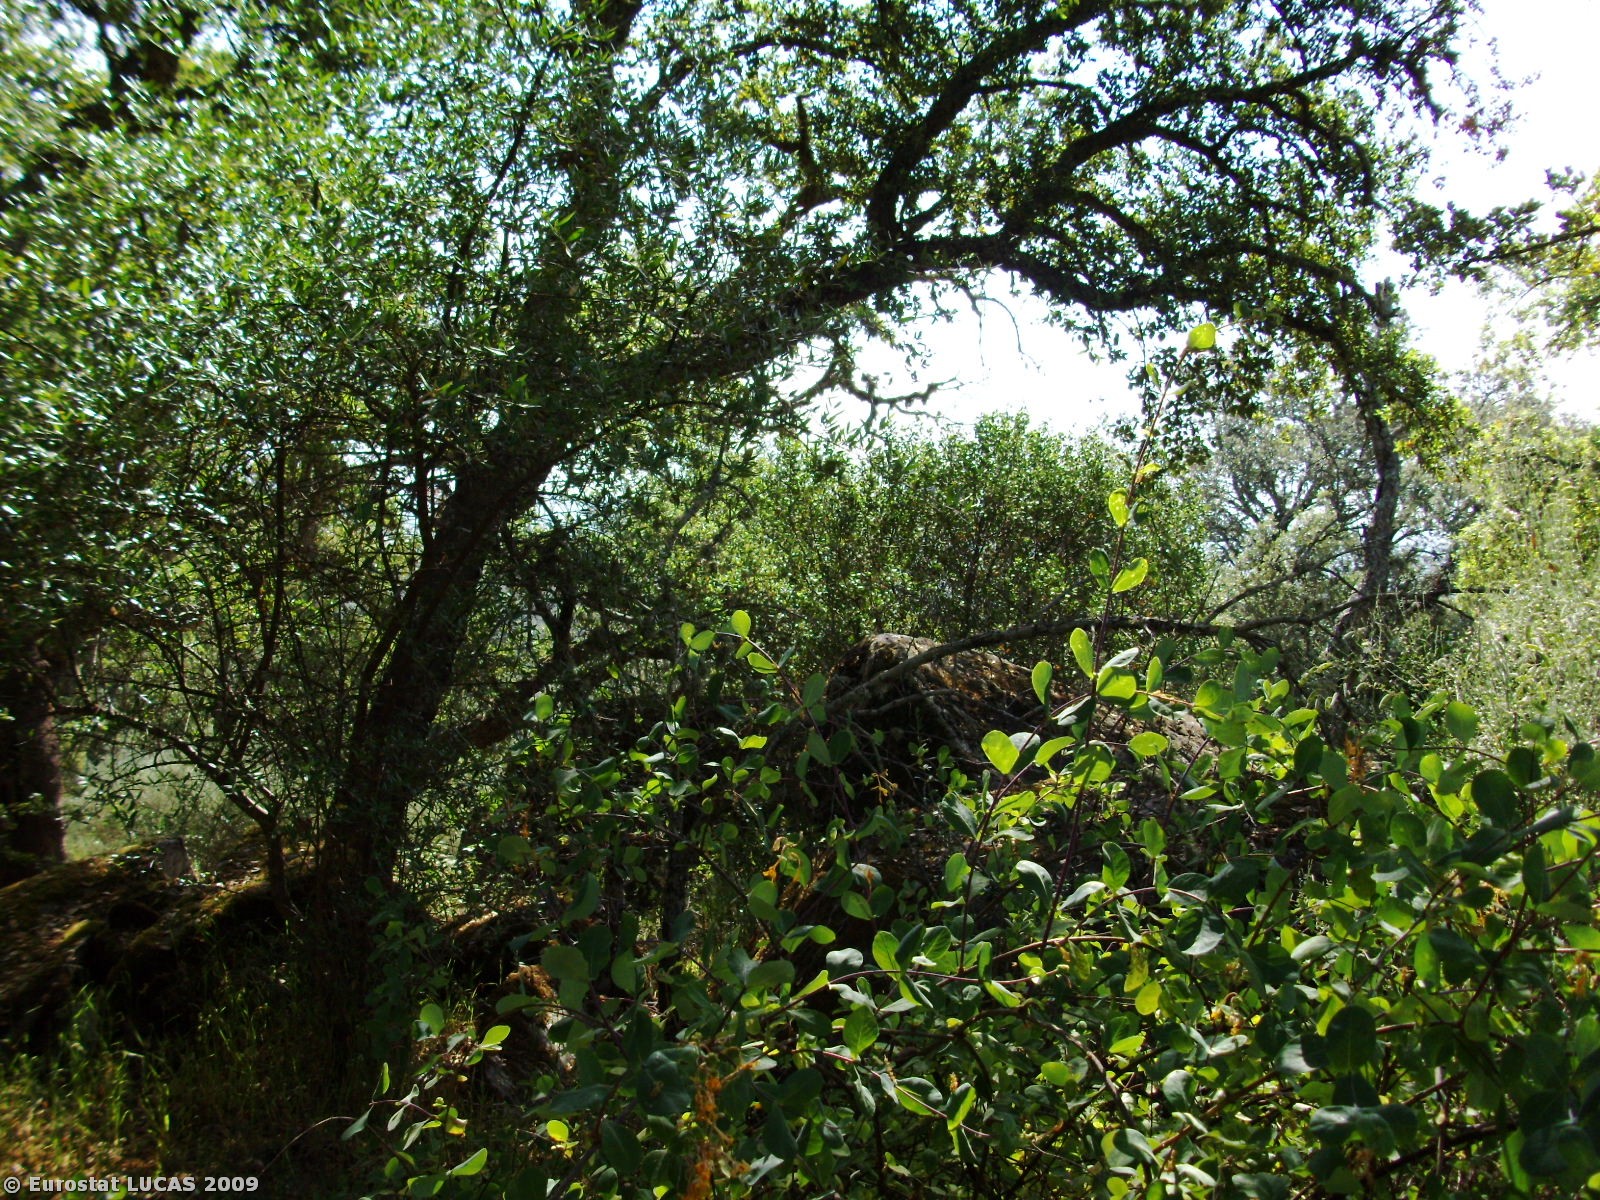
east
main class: Woodland
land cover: Broadleaved woodland
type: broadleaved evergreen forest
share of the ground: 50 - 75 %
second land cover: Shrubland with sparse tree cover
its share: 25 - 50 %
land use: Forestry
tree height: > 5 m
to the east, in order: Broadleaved woodland; Shrubland with sparse tree cover; Tracks; Fences; Spontaneously vegetated surfaces; Broadleaved woodland; Tracks; Broadleaved woodland; Shrubland without tree cover; Dry stone walls; Tracks; Spontaneously vegetated surfaces
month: May
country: PT
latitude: 39.2778
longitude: -7.4650
